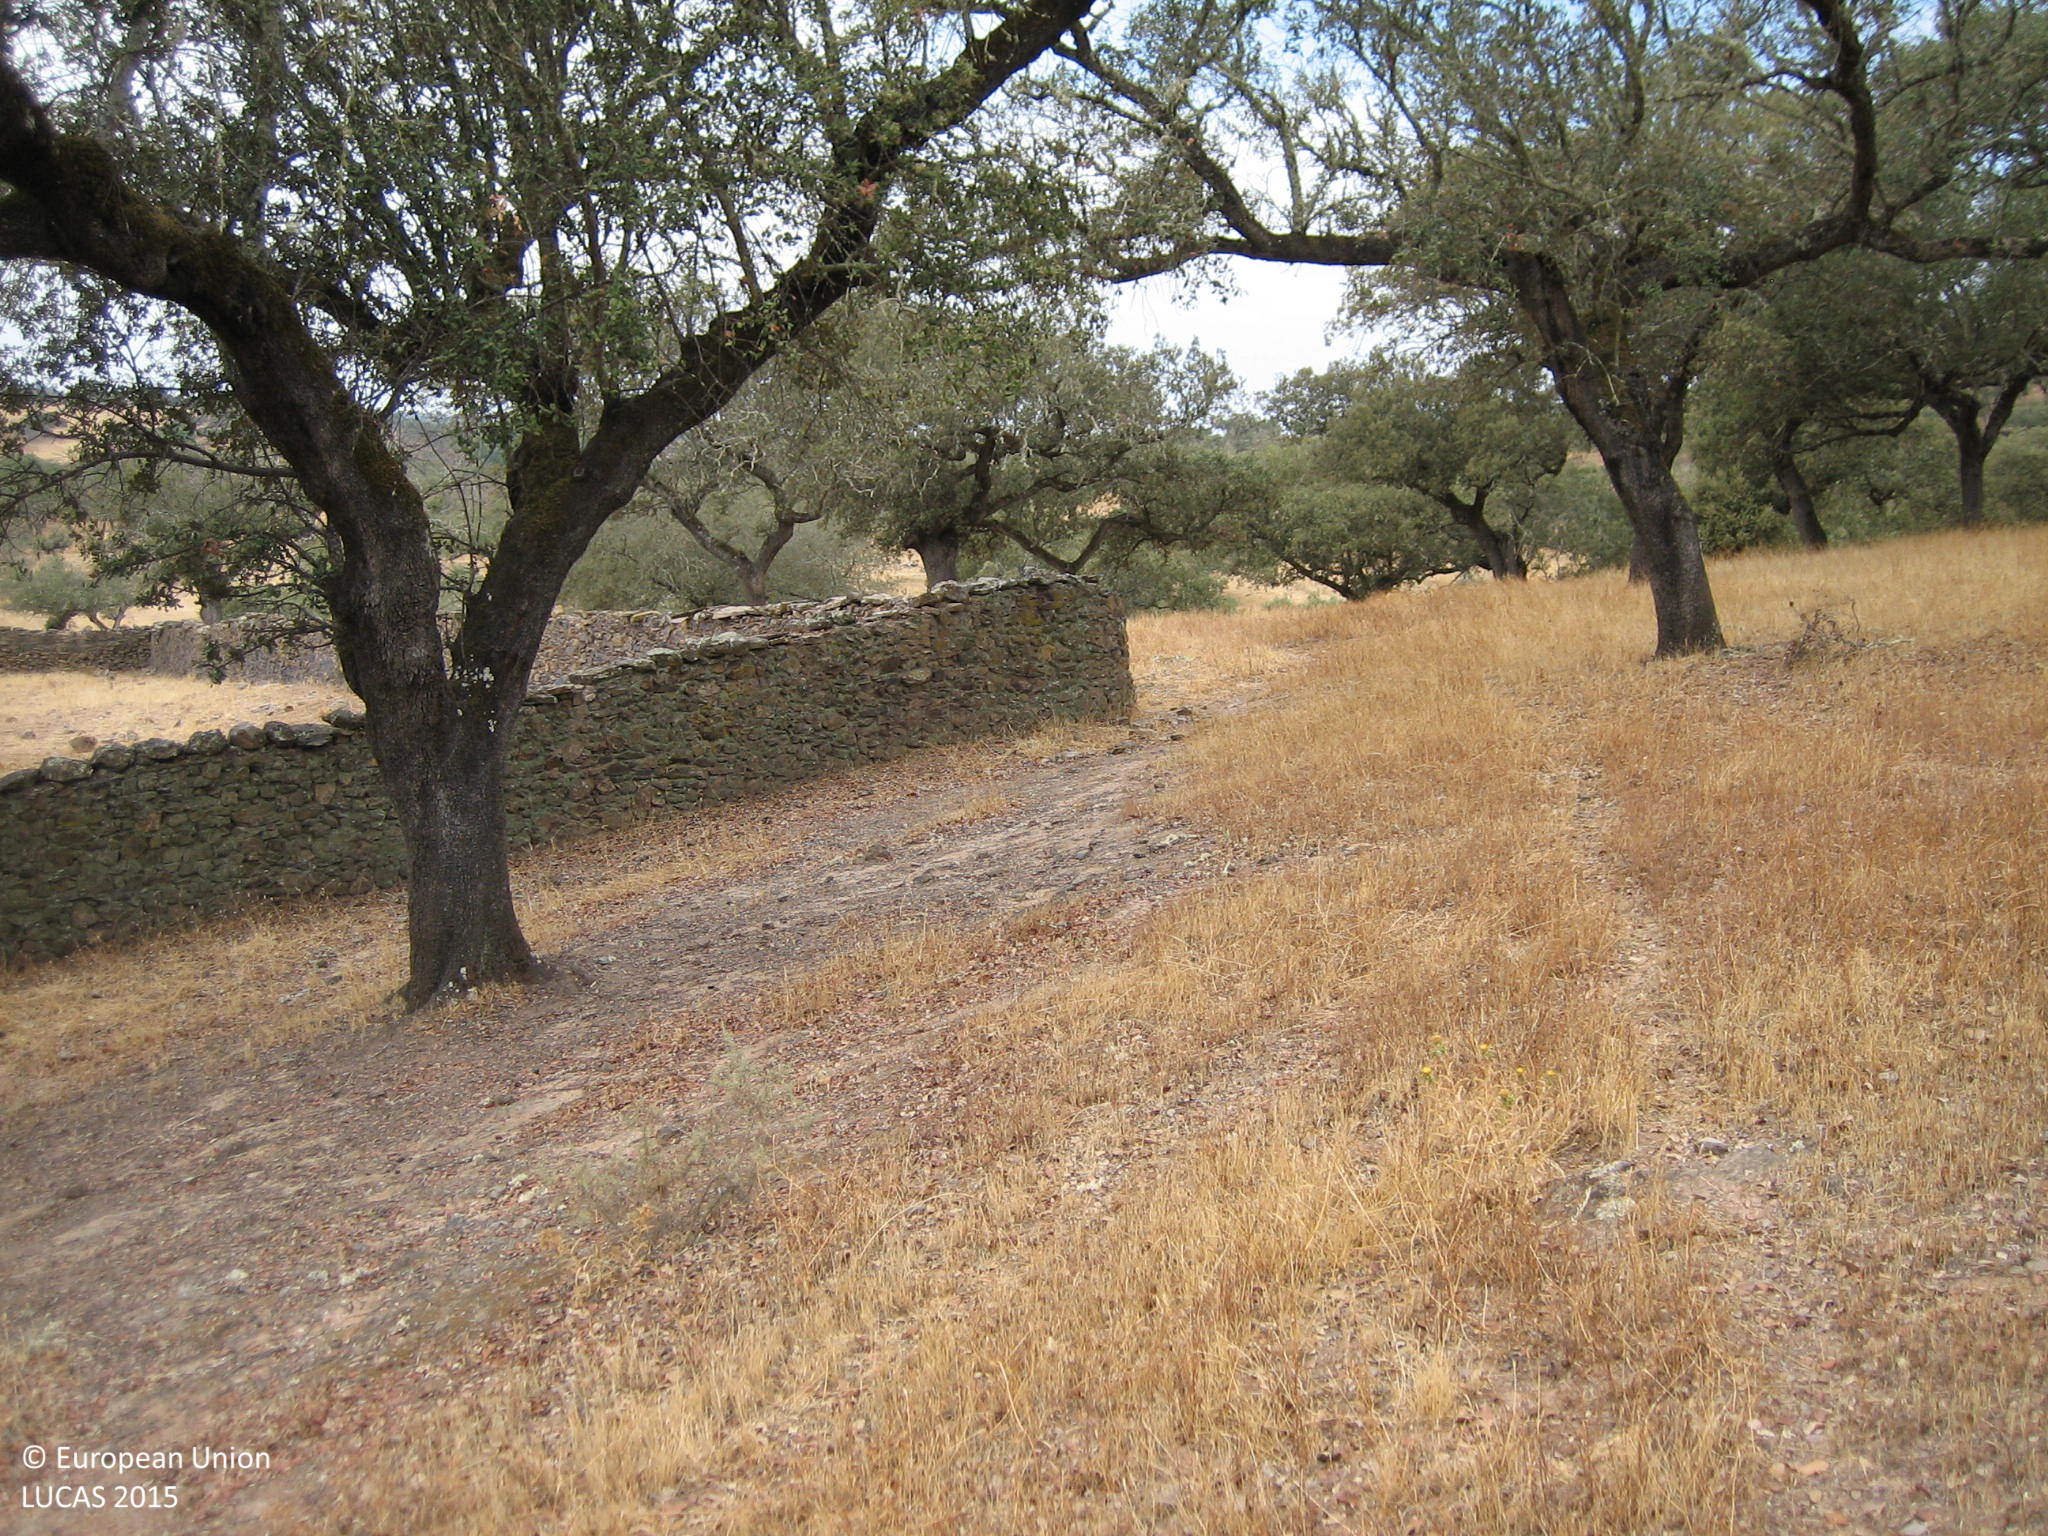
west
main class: Woodland
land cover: Broadleaved woodland
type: broadleaved evergreen forest
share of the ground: 25 - 50 %
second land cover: Grassland without tree/shrub cover
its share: > 75 %
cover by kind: herbaceous plants 60 %, broadleaved forest trees 40 %
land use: Forestry
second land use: Agriculture (excluding fallow land and kitchen gardens)
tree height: > 5 m
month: September
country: ES
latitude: 38.2552
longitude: -7.0997
